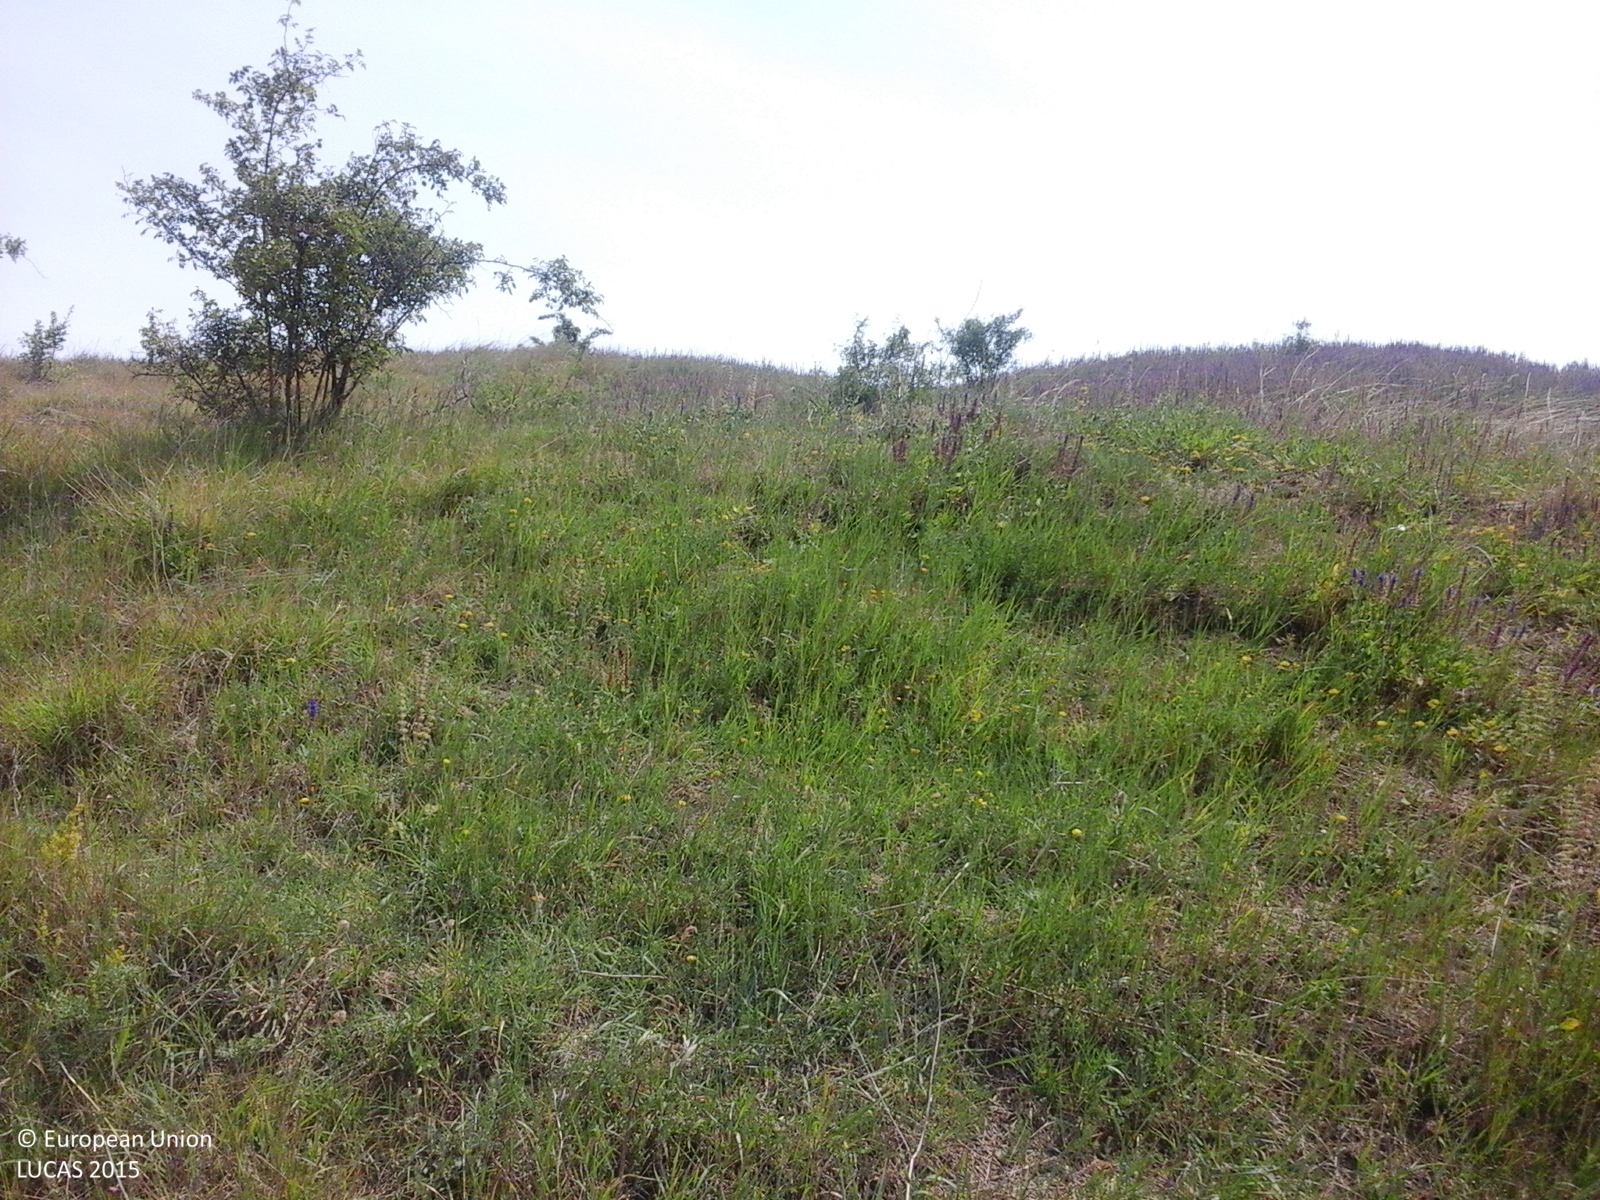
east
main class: Grassland
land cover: Grassland with sparse tree/shrub cover
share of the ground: > 75 %
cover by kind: herbaceous plants 90 %, broadleaved forest trees 5 %, shrubs 5 %
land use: Agriculture (excluding fallow land and kitchen gardens)
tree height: < 5 m
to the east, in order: Grassland with sparse tree/shrub cover; Abandoned hedges; Grass margins; Tracks; Grass margins; Common wheat
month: June
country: RO
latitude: 47.4094
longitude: 26.9721
